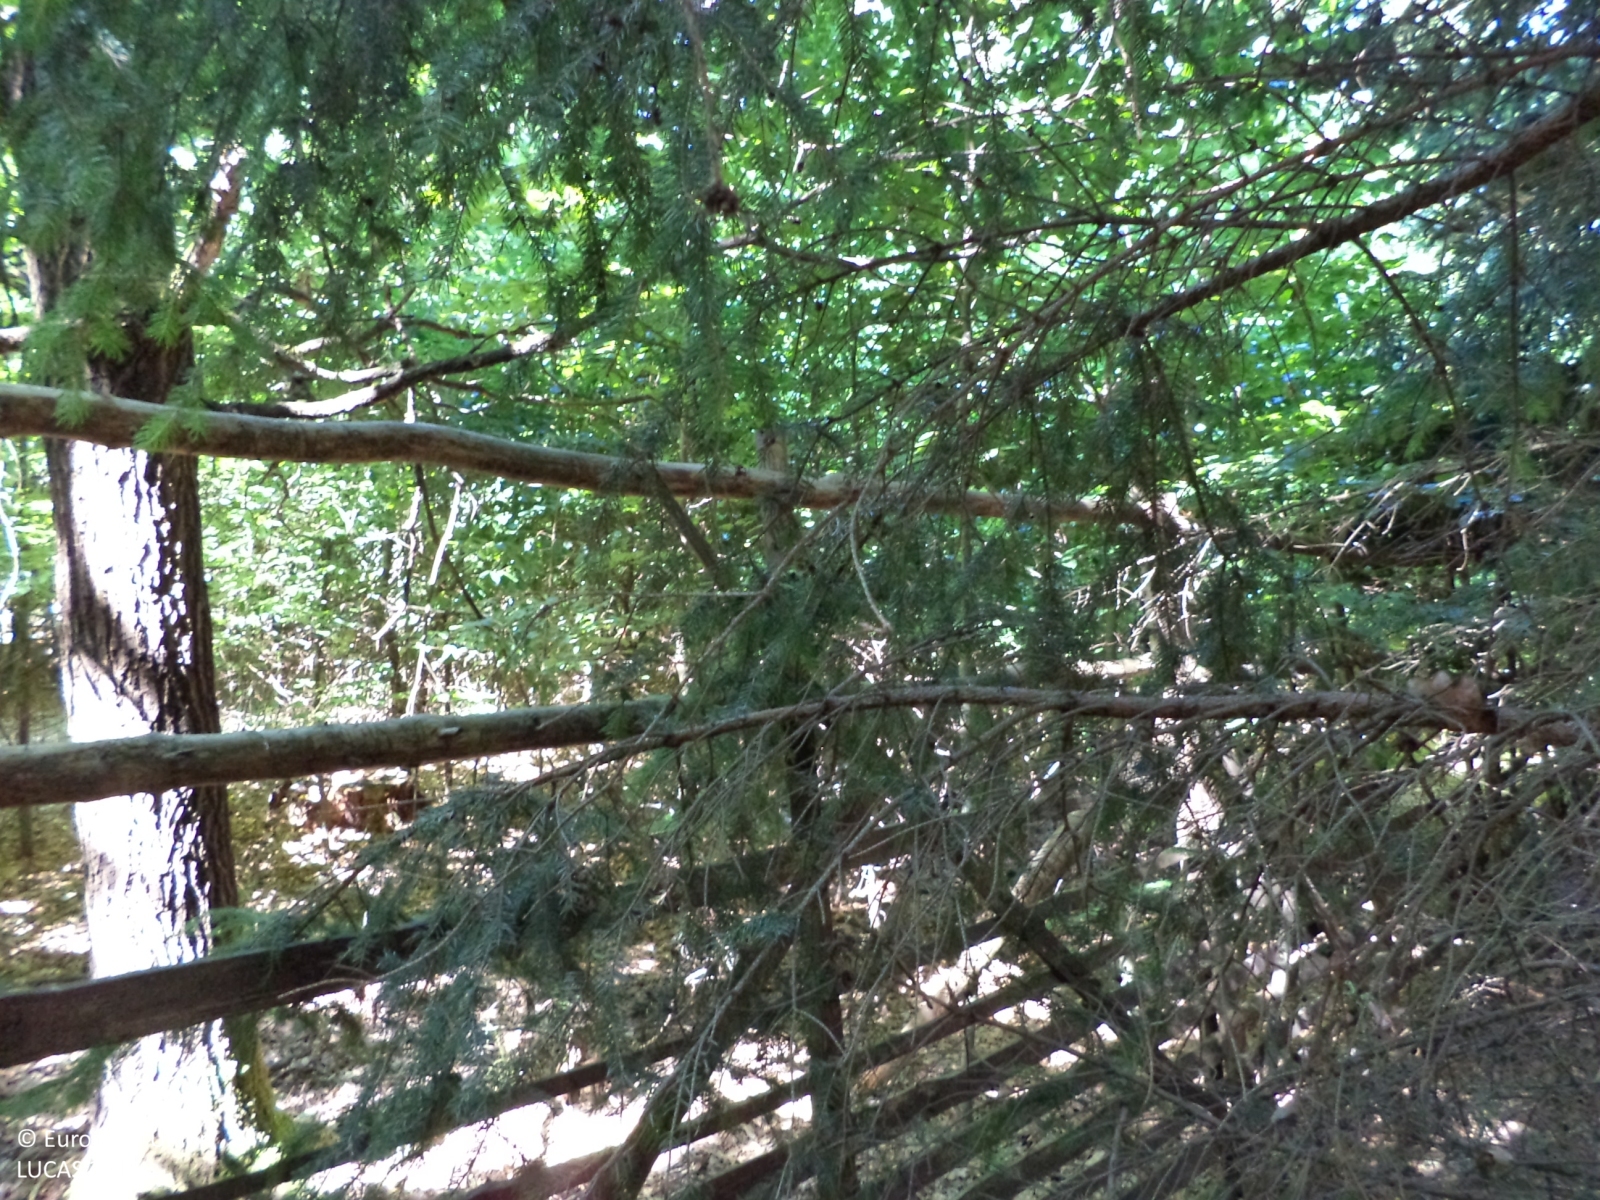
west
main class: Woodland
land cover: Spruce dominated coniferous woodland
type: hemiboreal forest and nemoral coniferous forest and mixed broadleaved-coniferous forest
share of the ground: > 75 %
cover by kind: coniferous forest trees 100 %
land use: Forestry
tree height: > 5 m
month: July
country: CZ
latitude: 49.9729
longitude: 13.9188
